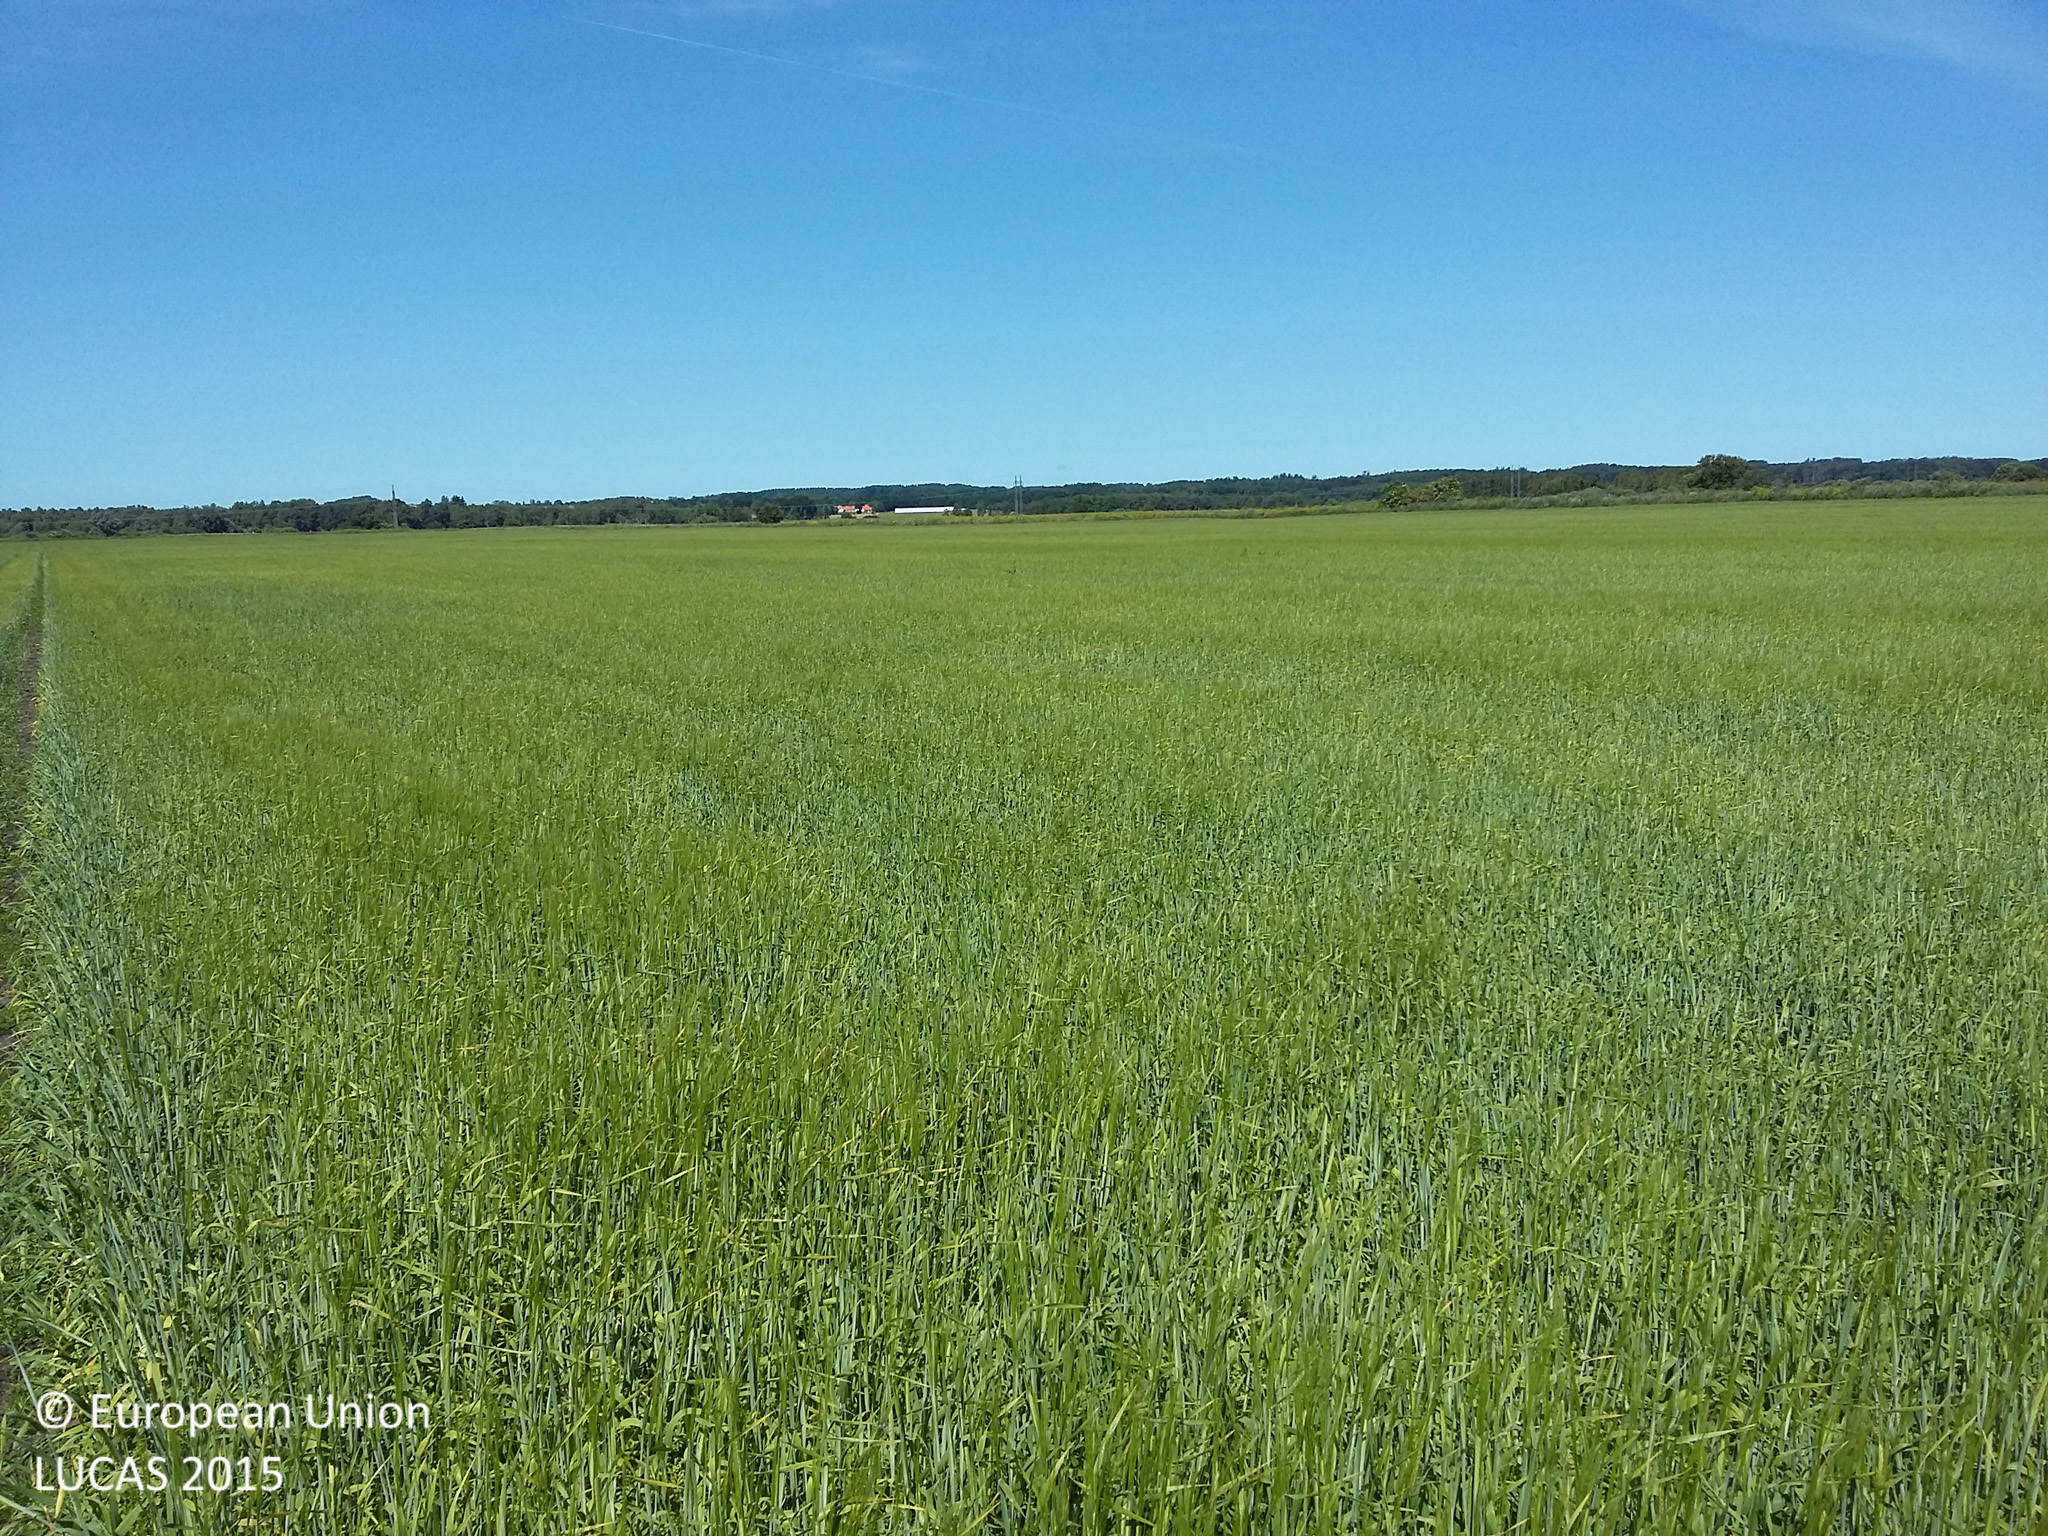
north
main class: Cropland
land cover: Barley
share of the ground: > 75 %
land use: Agriculture (excluding fallow land and kitchen gardens)
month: July
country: DK
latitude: 55.5853
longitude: 11.5375
